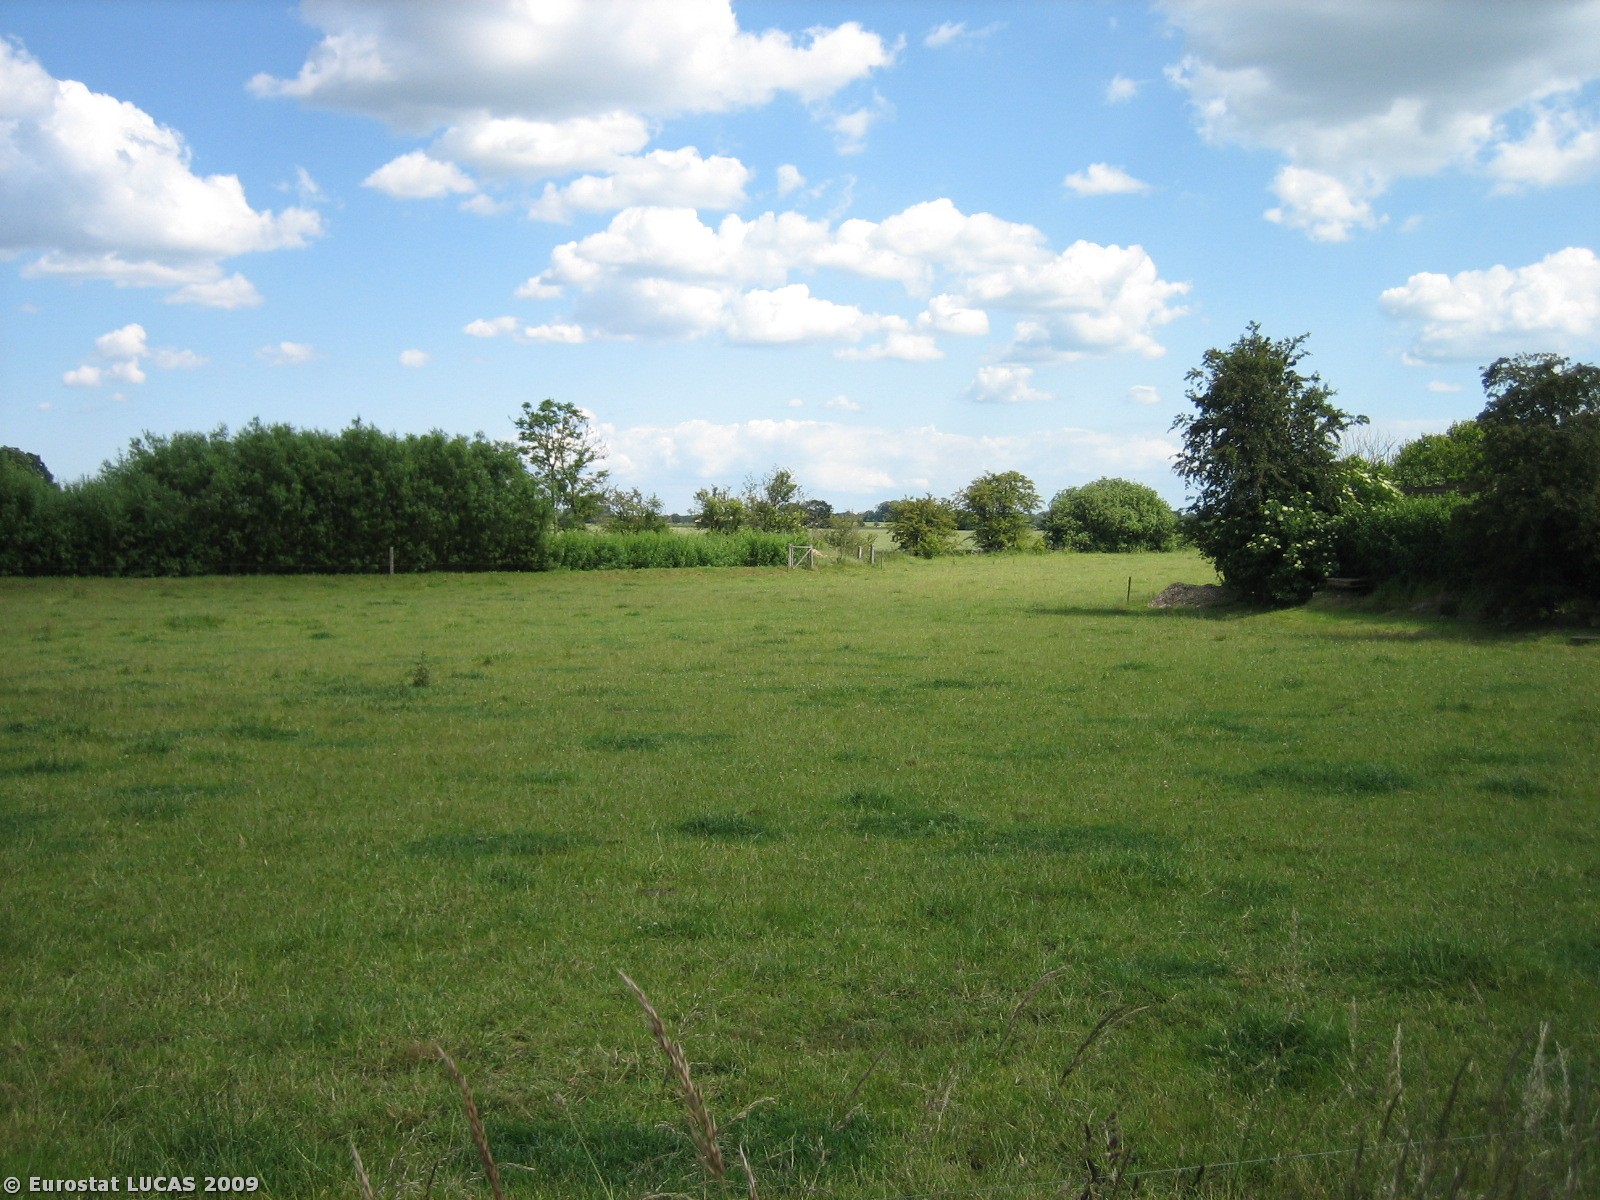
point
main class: Woodland
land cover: Broadleaved woodland
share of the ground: > 75 %
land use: Forestry
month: June
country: DK
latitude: 55.5381
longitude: 9.1926
